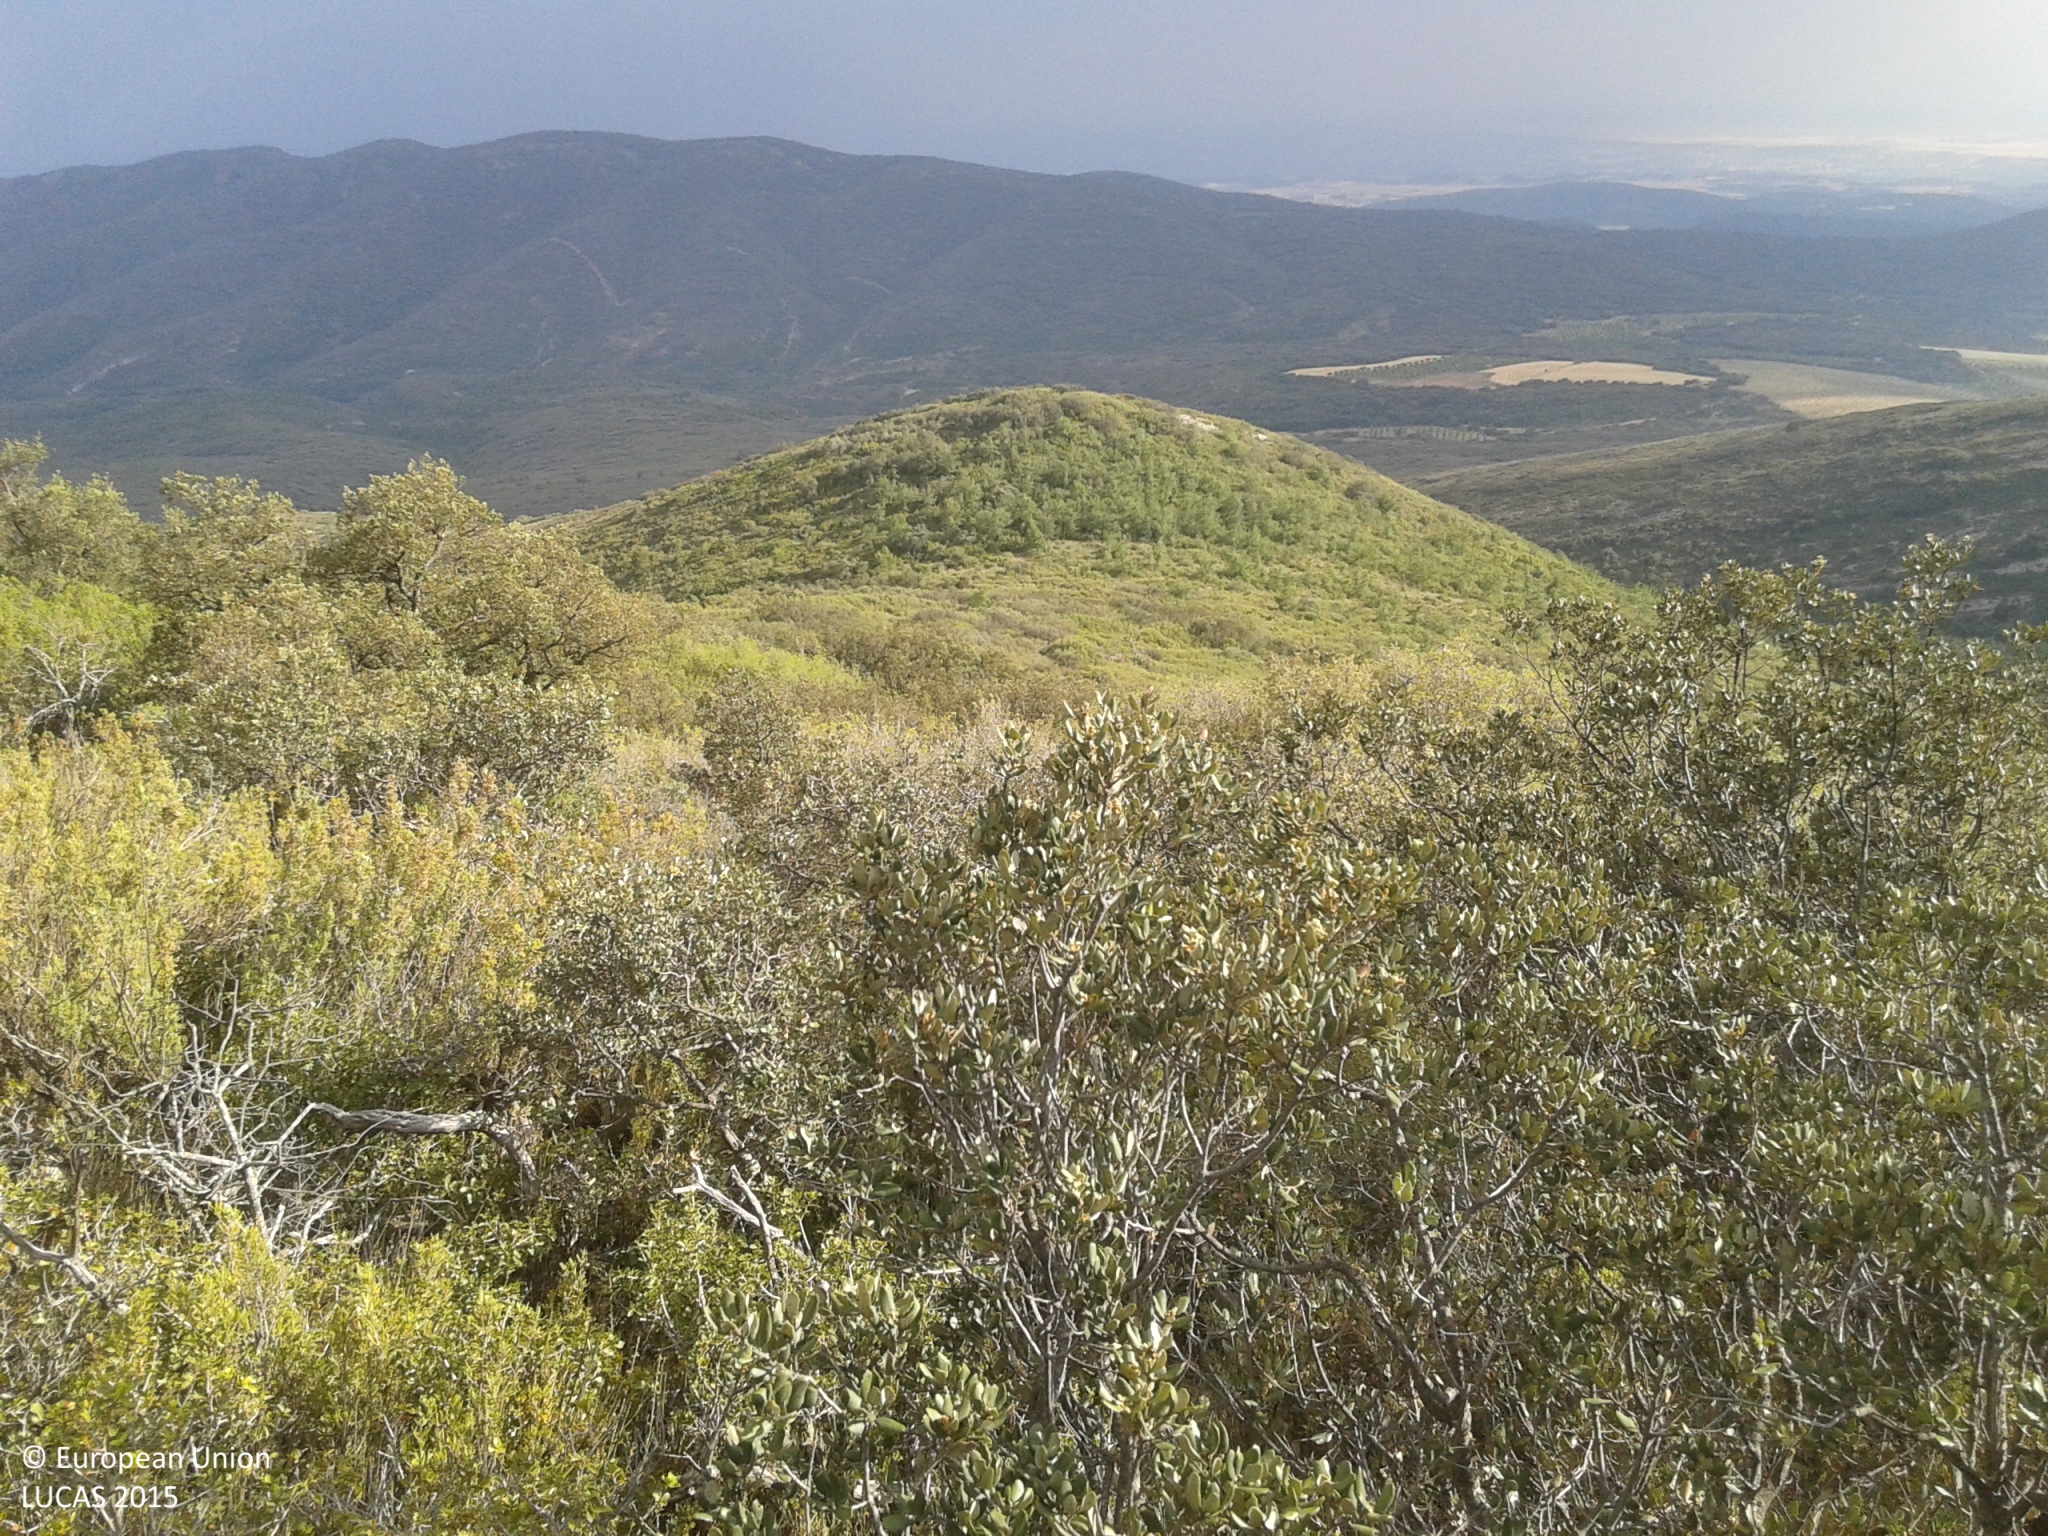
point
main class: Woodland
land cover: Broadleaved woodland
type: broadleaved evergreen forest
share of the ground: 25 - 50 %
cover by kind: shrubs 60 %, broadleaved forest trees 40 %
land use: Semi-natural and natural areas not in use
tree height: < 5 m
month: June
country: ES
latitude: 41.9132
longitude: 0.6660
